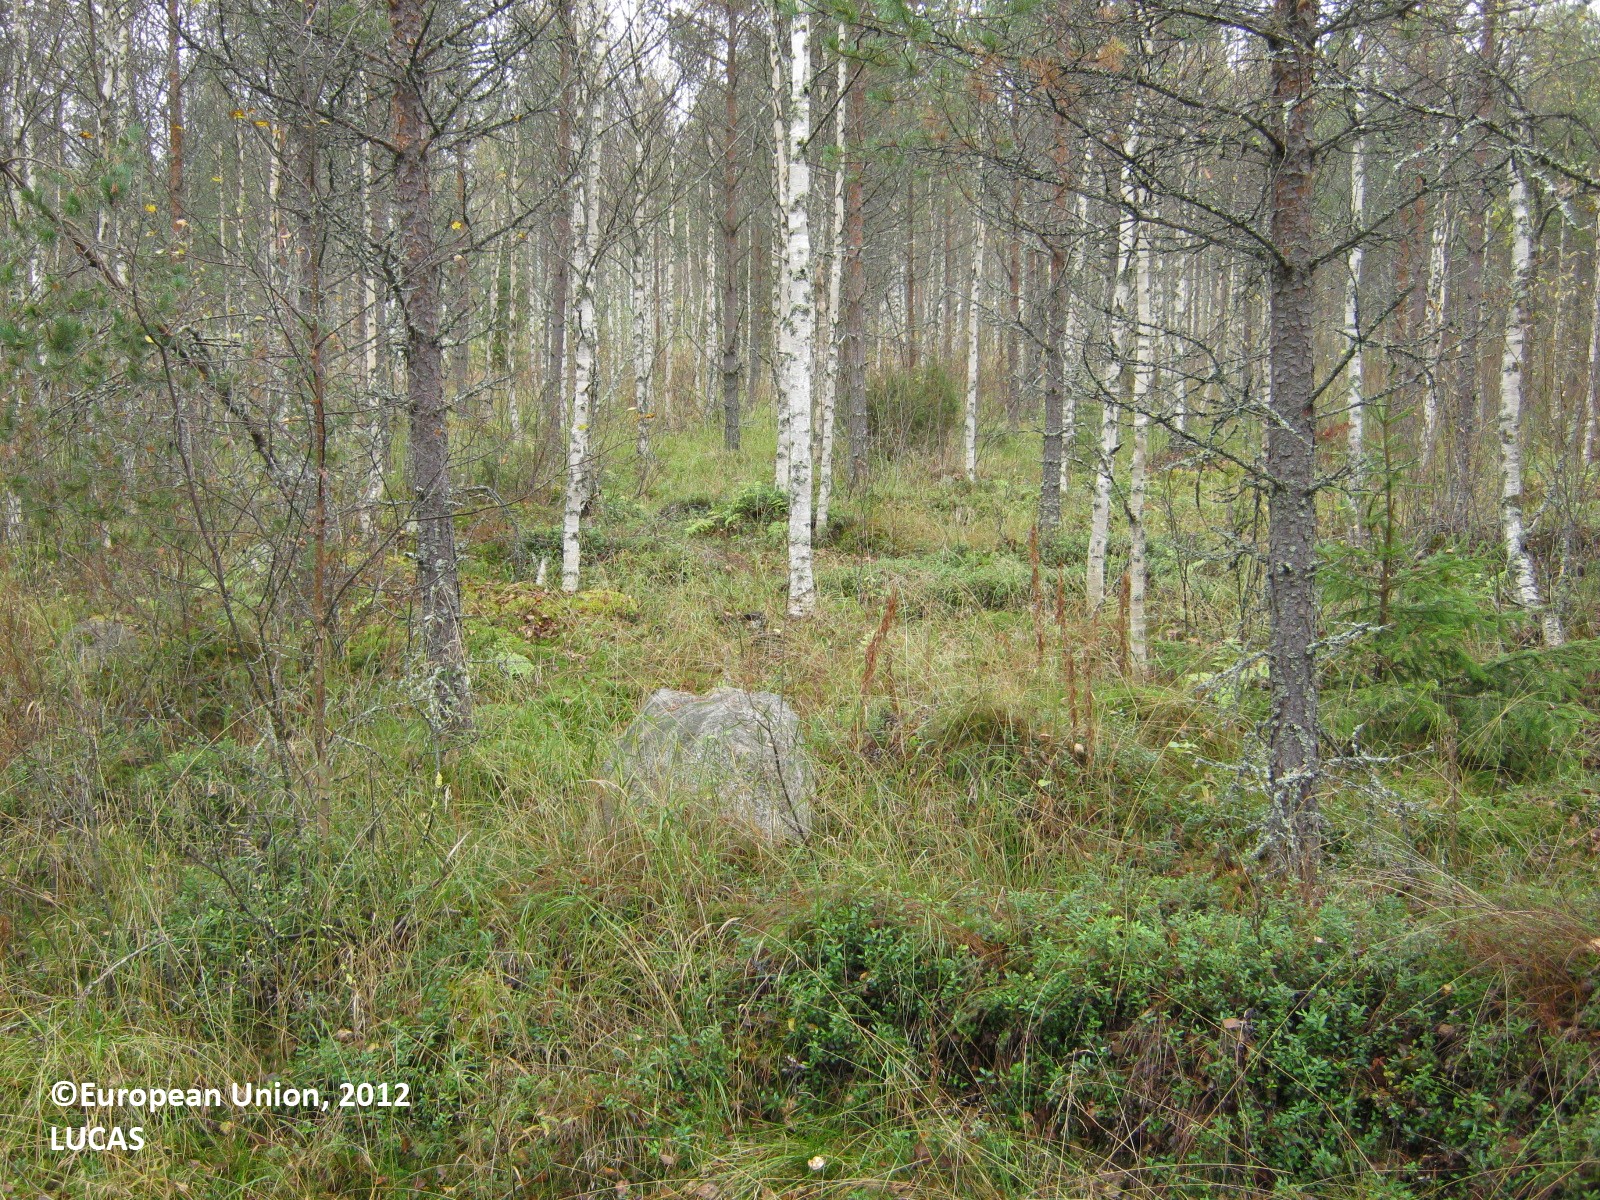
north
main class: Woodland
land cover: Other mixed woodland
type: boreal forest
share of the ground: > 75 %
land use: Forestry
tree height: > 5 m
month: September
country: FI
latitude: 63.3813
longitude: 25.9372
